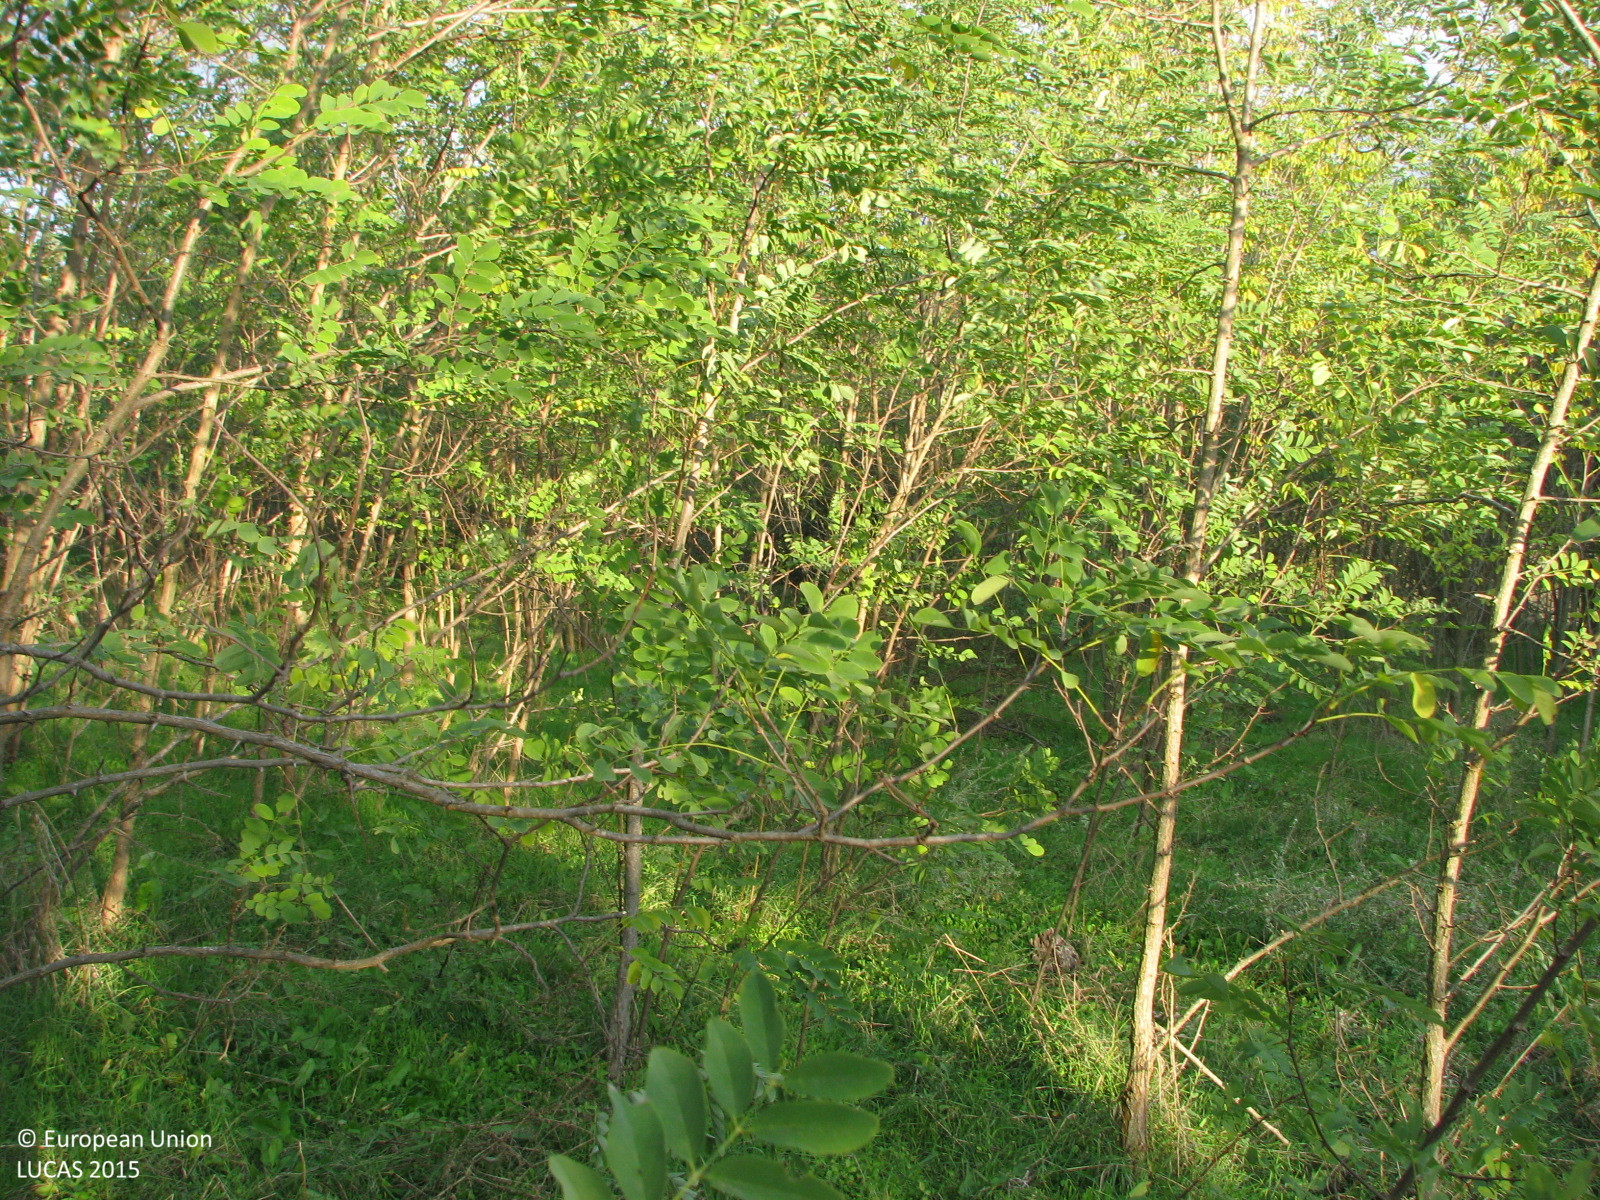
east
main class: Woodland
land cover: Broadleaved woodland
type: thermophilous deciduous forest
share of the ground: 50 - 75 %
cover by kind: broadleaved forest trees 70 %, herbaceous plants 20 %, shrubs 10 %
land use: Semi-natural and natural areas not in use
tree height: < 5 m
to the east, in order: Broadleaved woodland; Tracks; Broadleaved woodland; Tracks; Broadleaved woodland; Grassland without tree/shrub cover; Tracks; Other bare soil
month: October
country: BG
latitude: 42.2440
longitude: 26.7342
